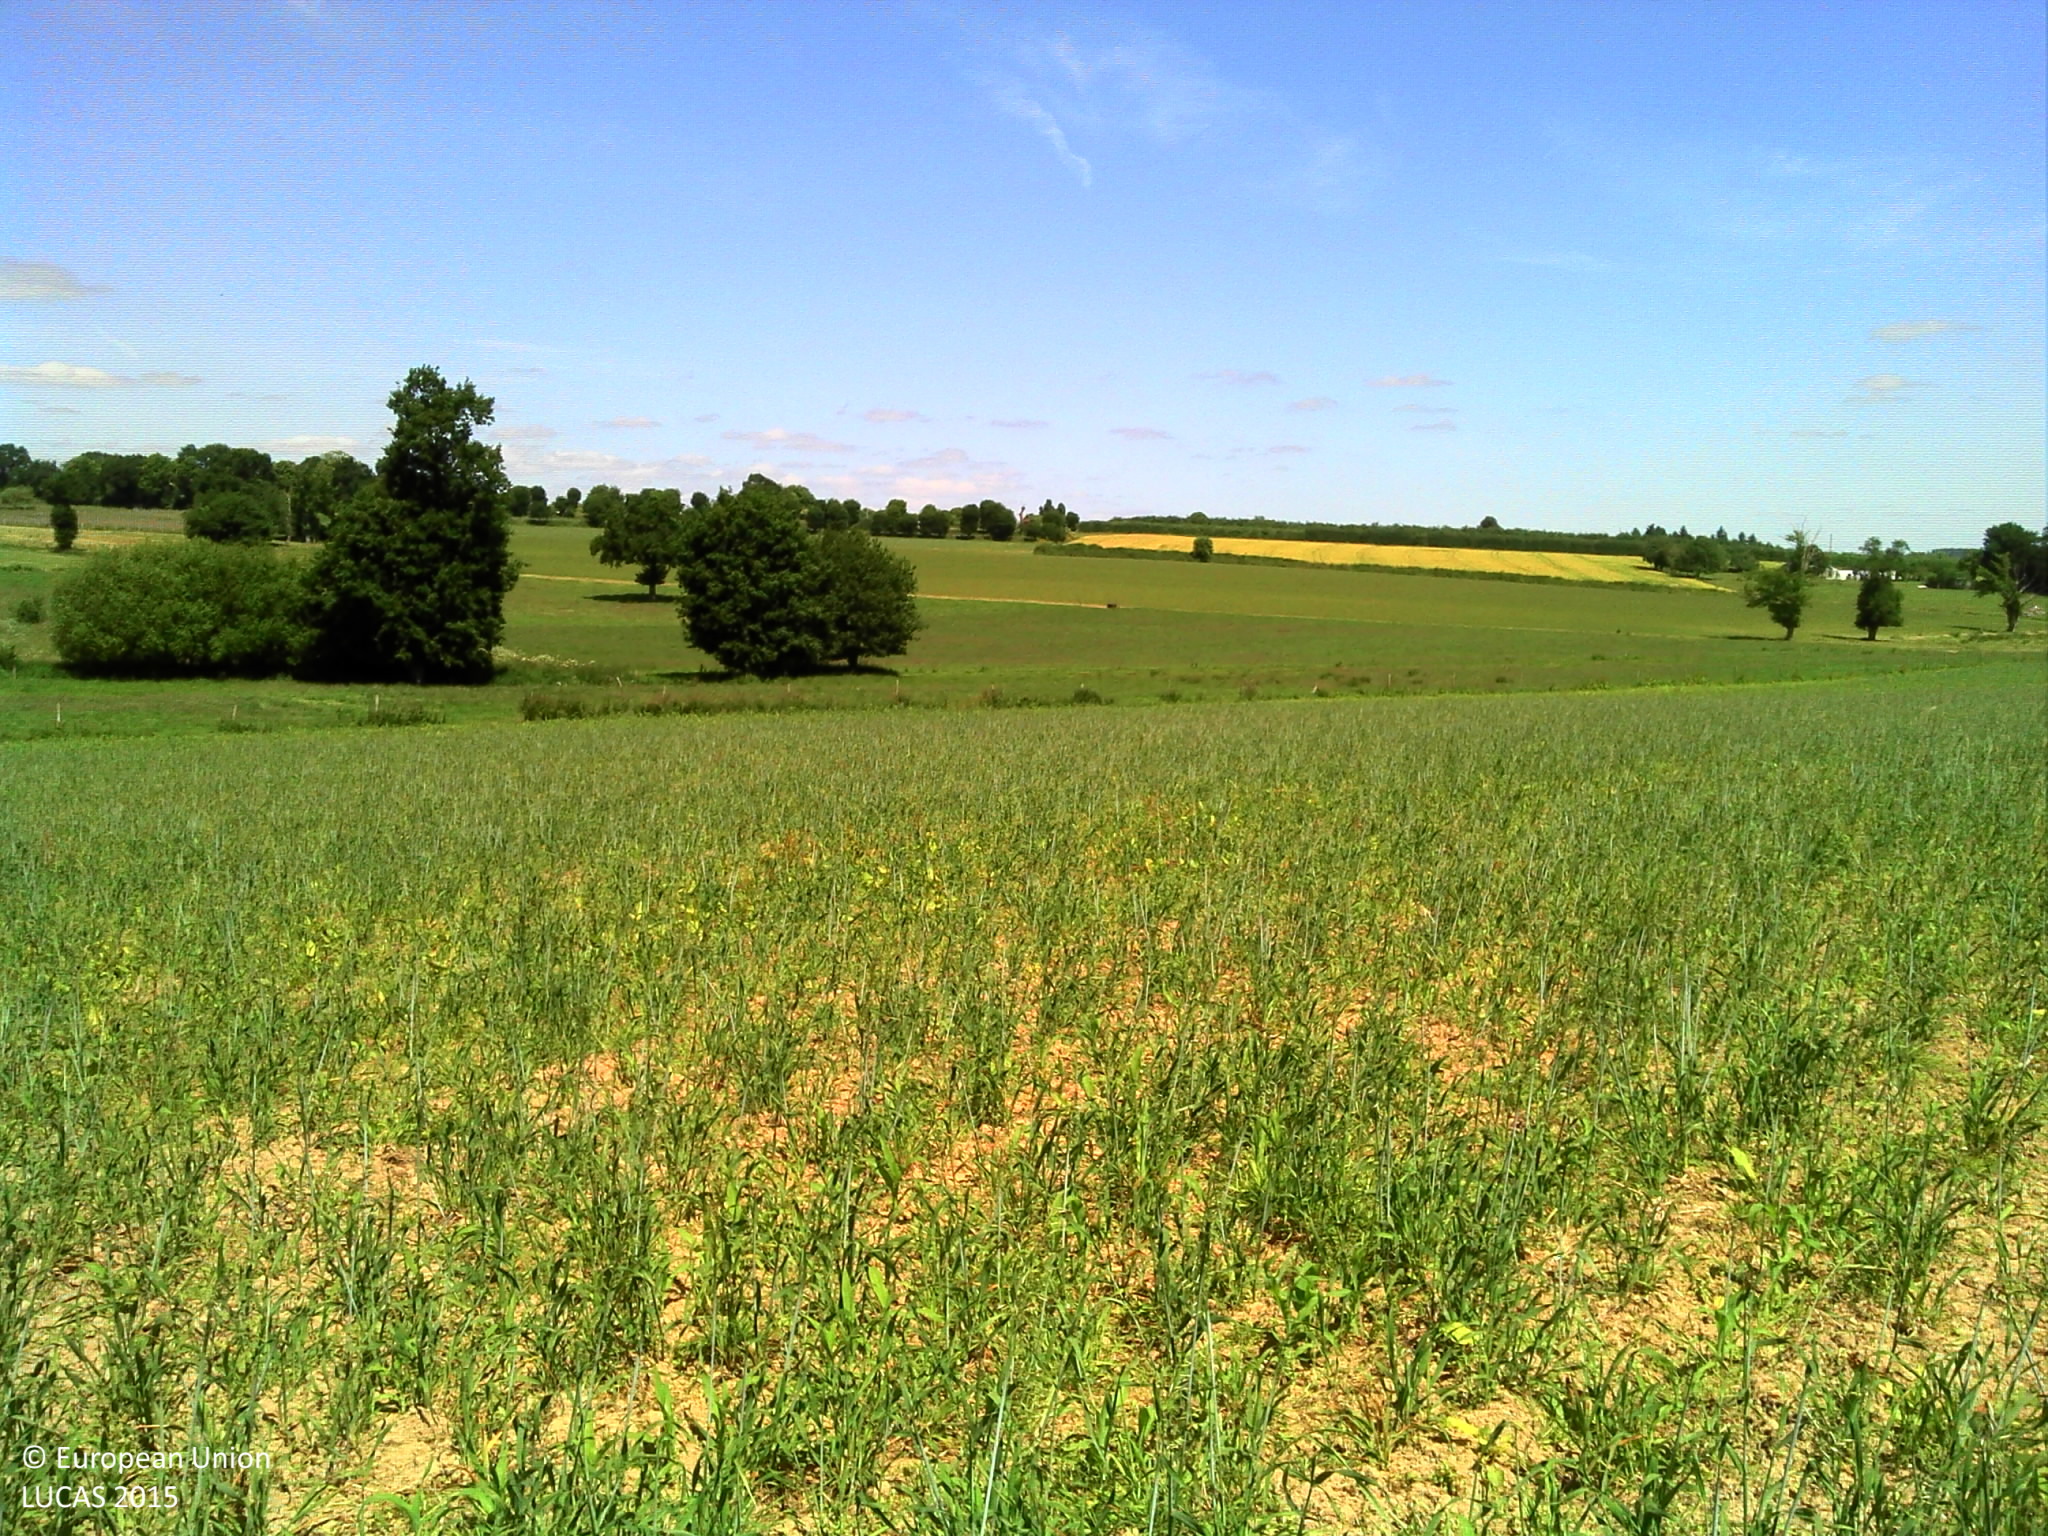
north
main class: Cropland
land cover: Maize
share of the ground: > 75 %
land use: Agriculture (excluding fallow land and kitchen gardens)
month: June
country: FR
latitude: 48.0950
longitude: -1.4717
